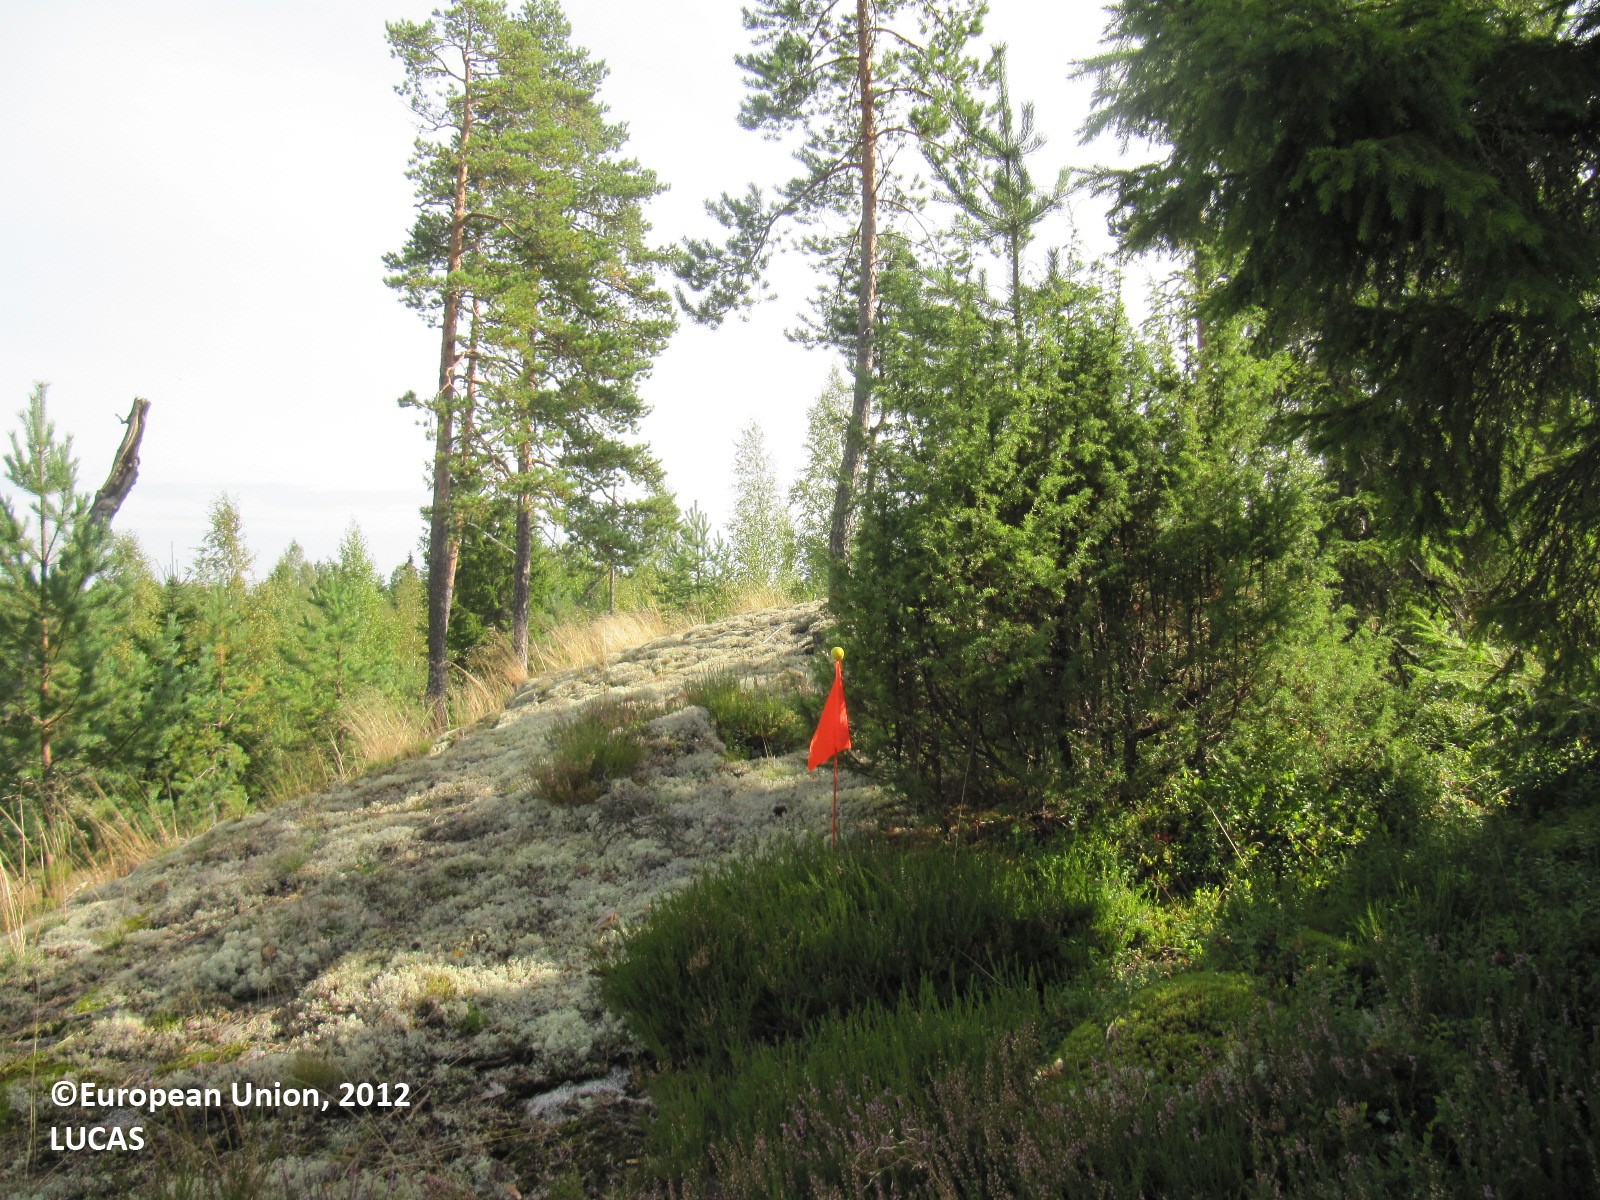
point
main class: Woodland
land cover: Pine dominated mixed woodland
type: boreal forest
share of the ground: 25 - 50 %
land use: Forestry
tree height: > 5 m
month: August
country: FI
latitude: 61.0120
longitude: 22.8918
